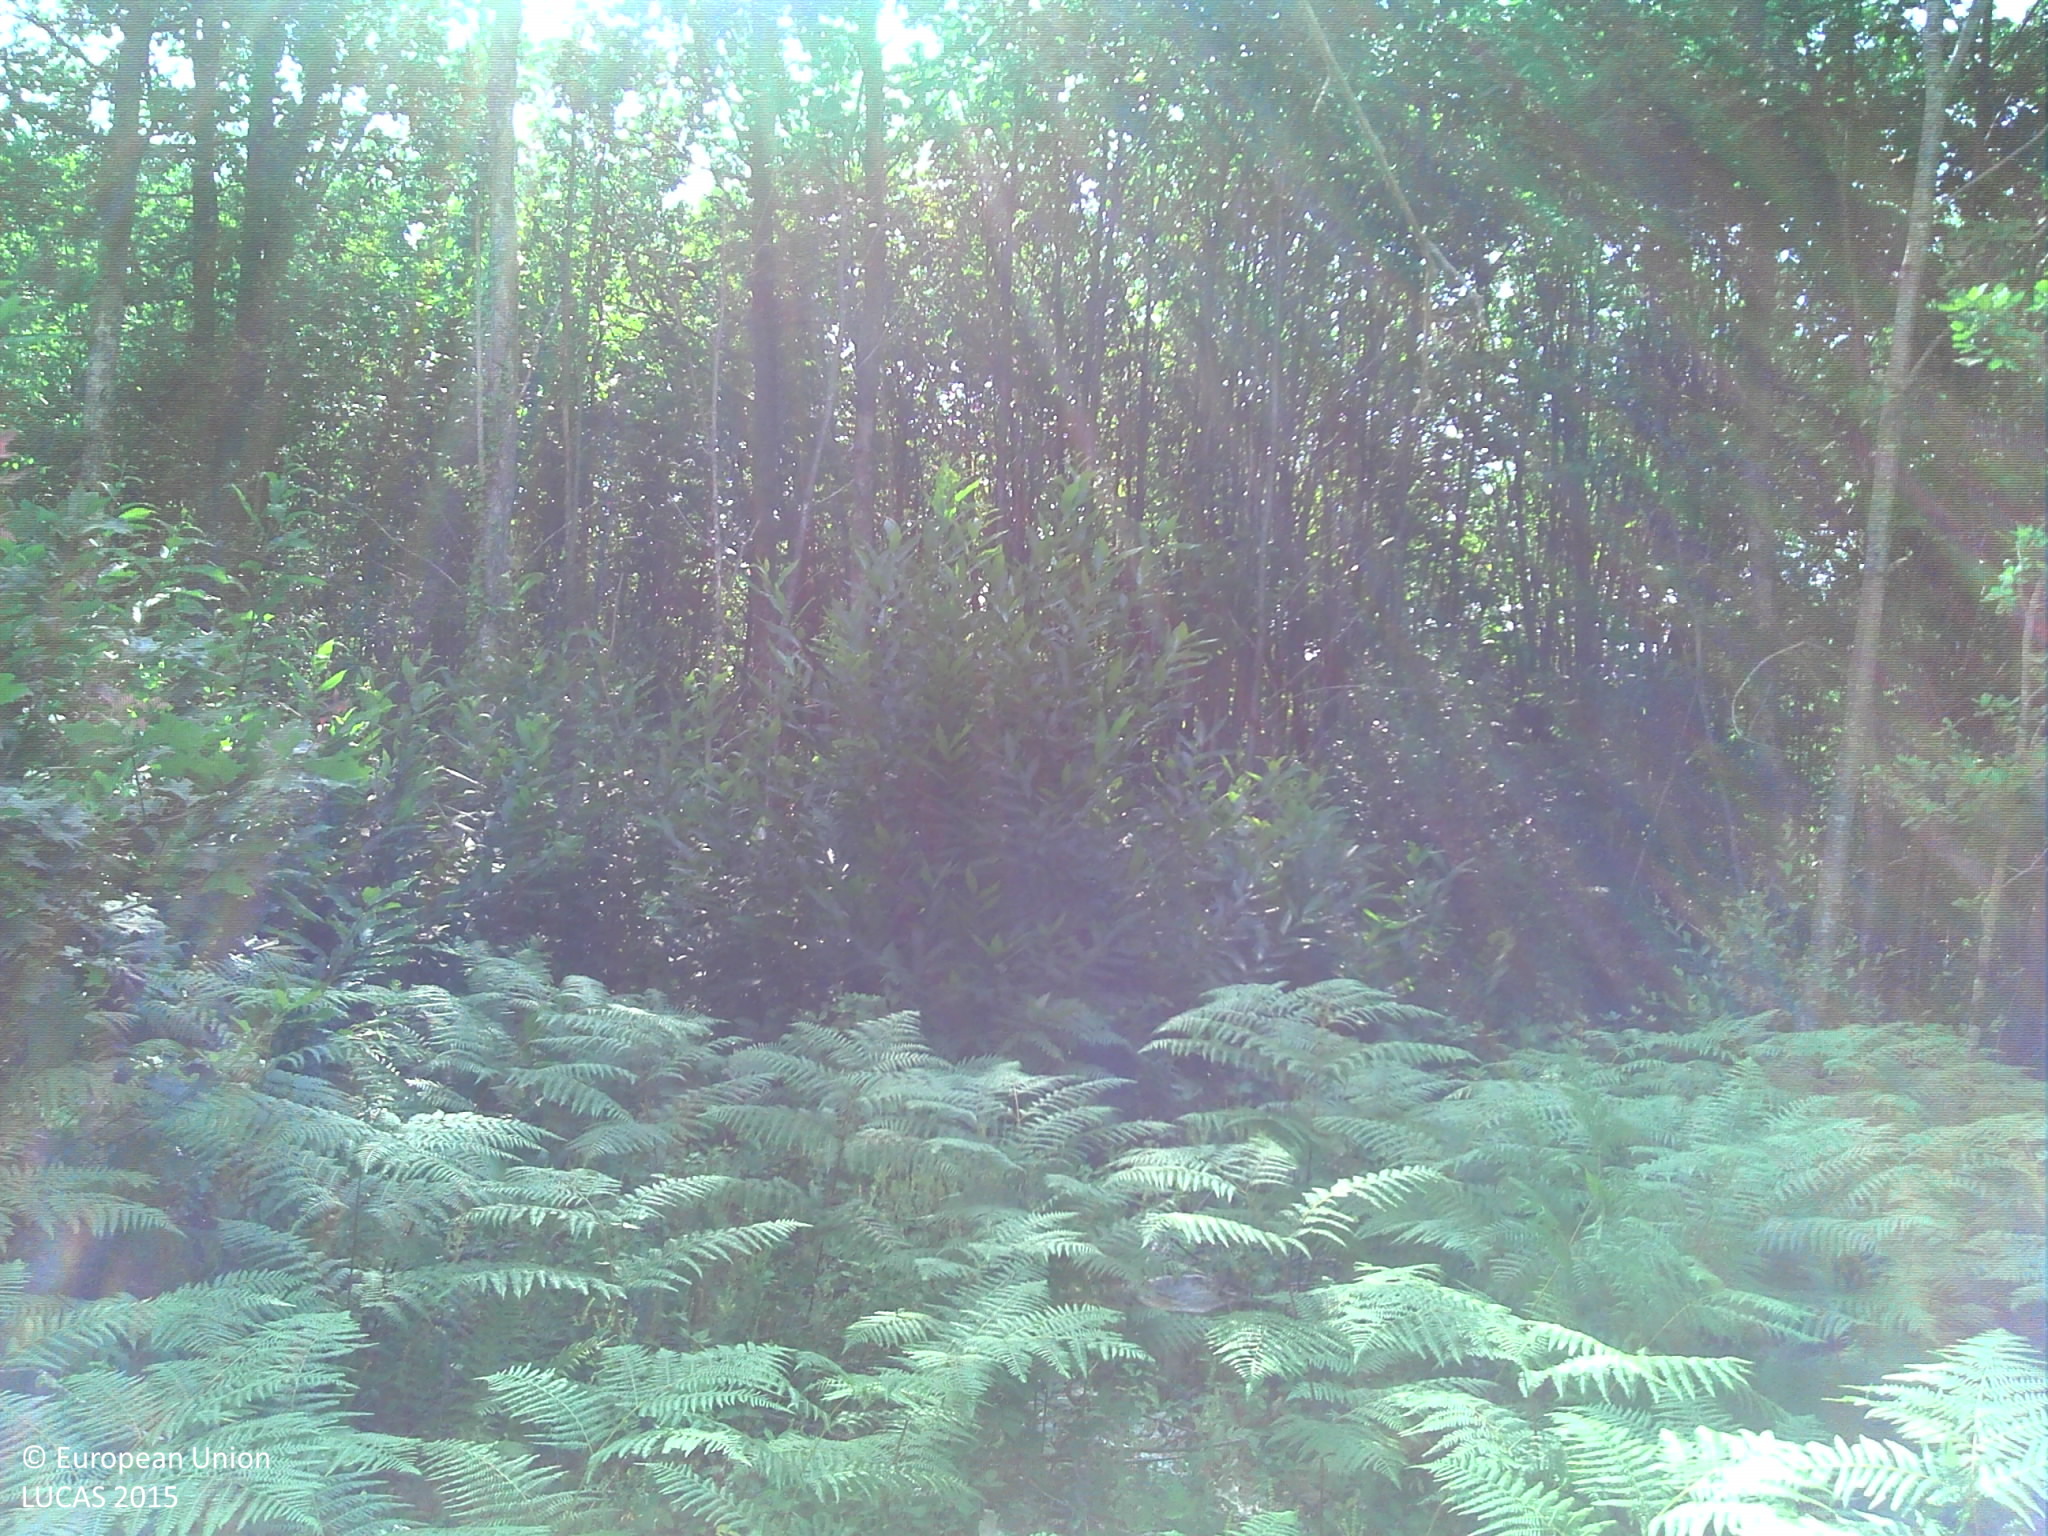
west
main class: Woodland
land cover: Pine dominated mixed woodland
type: acidophilous oak and oak-birch forest
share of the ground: > 75 %
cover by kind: herbaceous plants 40 %, broadleaved forest trees 25 %, lichens and mosses 20 %, coniferous forest trees 10 %
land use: Forestry
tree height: > 5 m
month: July
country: FR
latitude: 45.6804
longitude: 0.9898
